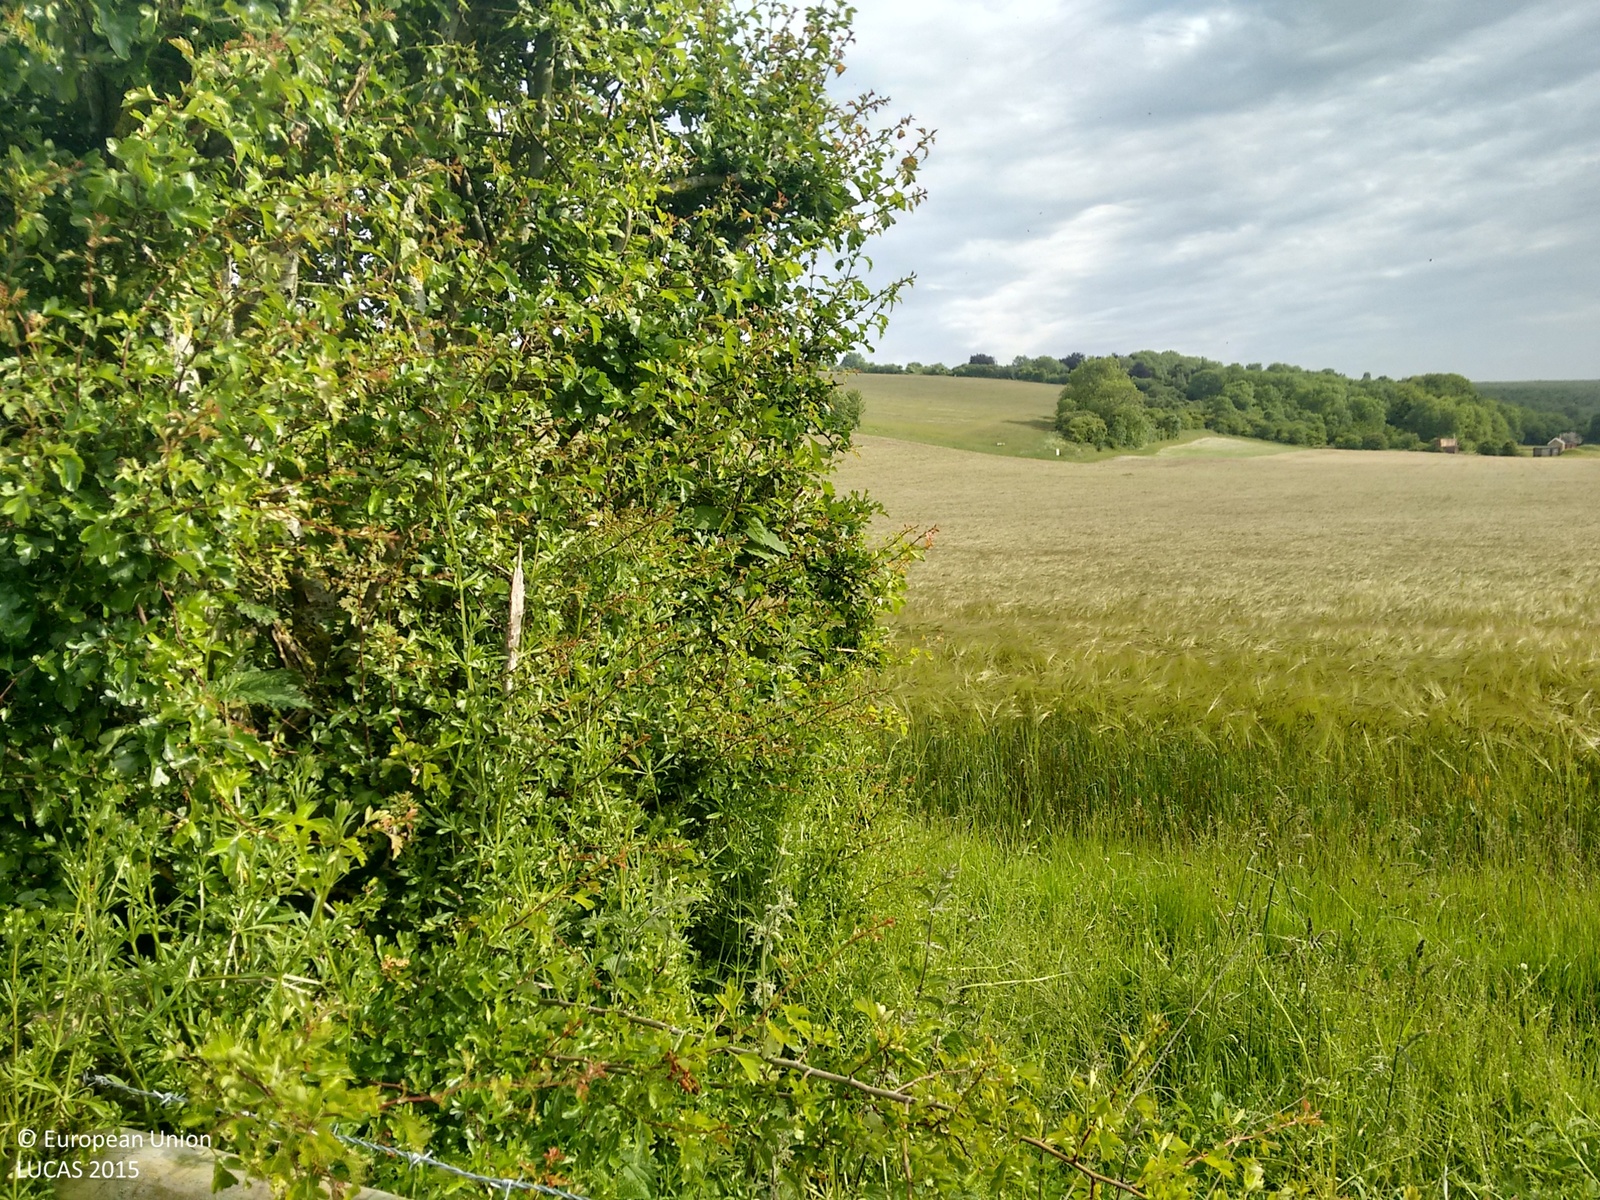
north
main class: Cropland
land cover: Barley
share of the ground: > 75 %
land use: Agriculture (excluding fallow land and kitchen gardens)
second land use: Community services
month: June
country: GB
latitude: 51.2220
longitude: -2.1599
